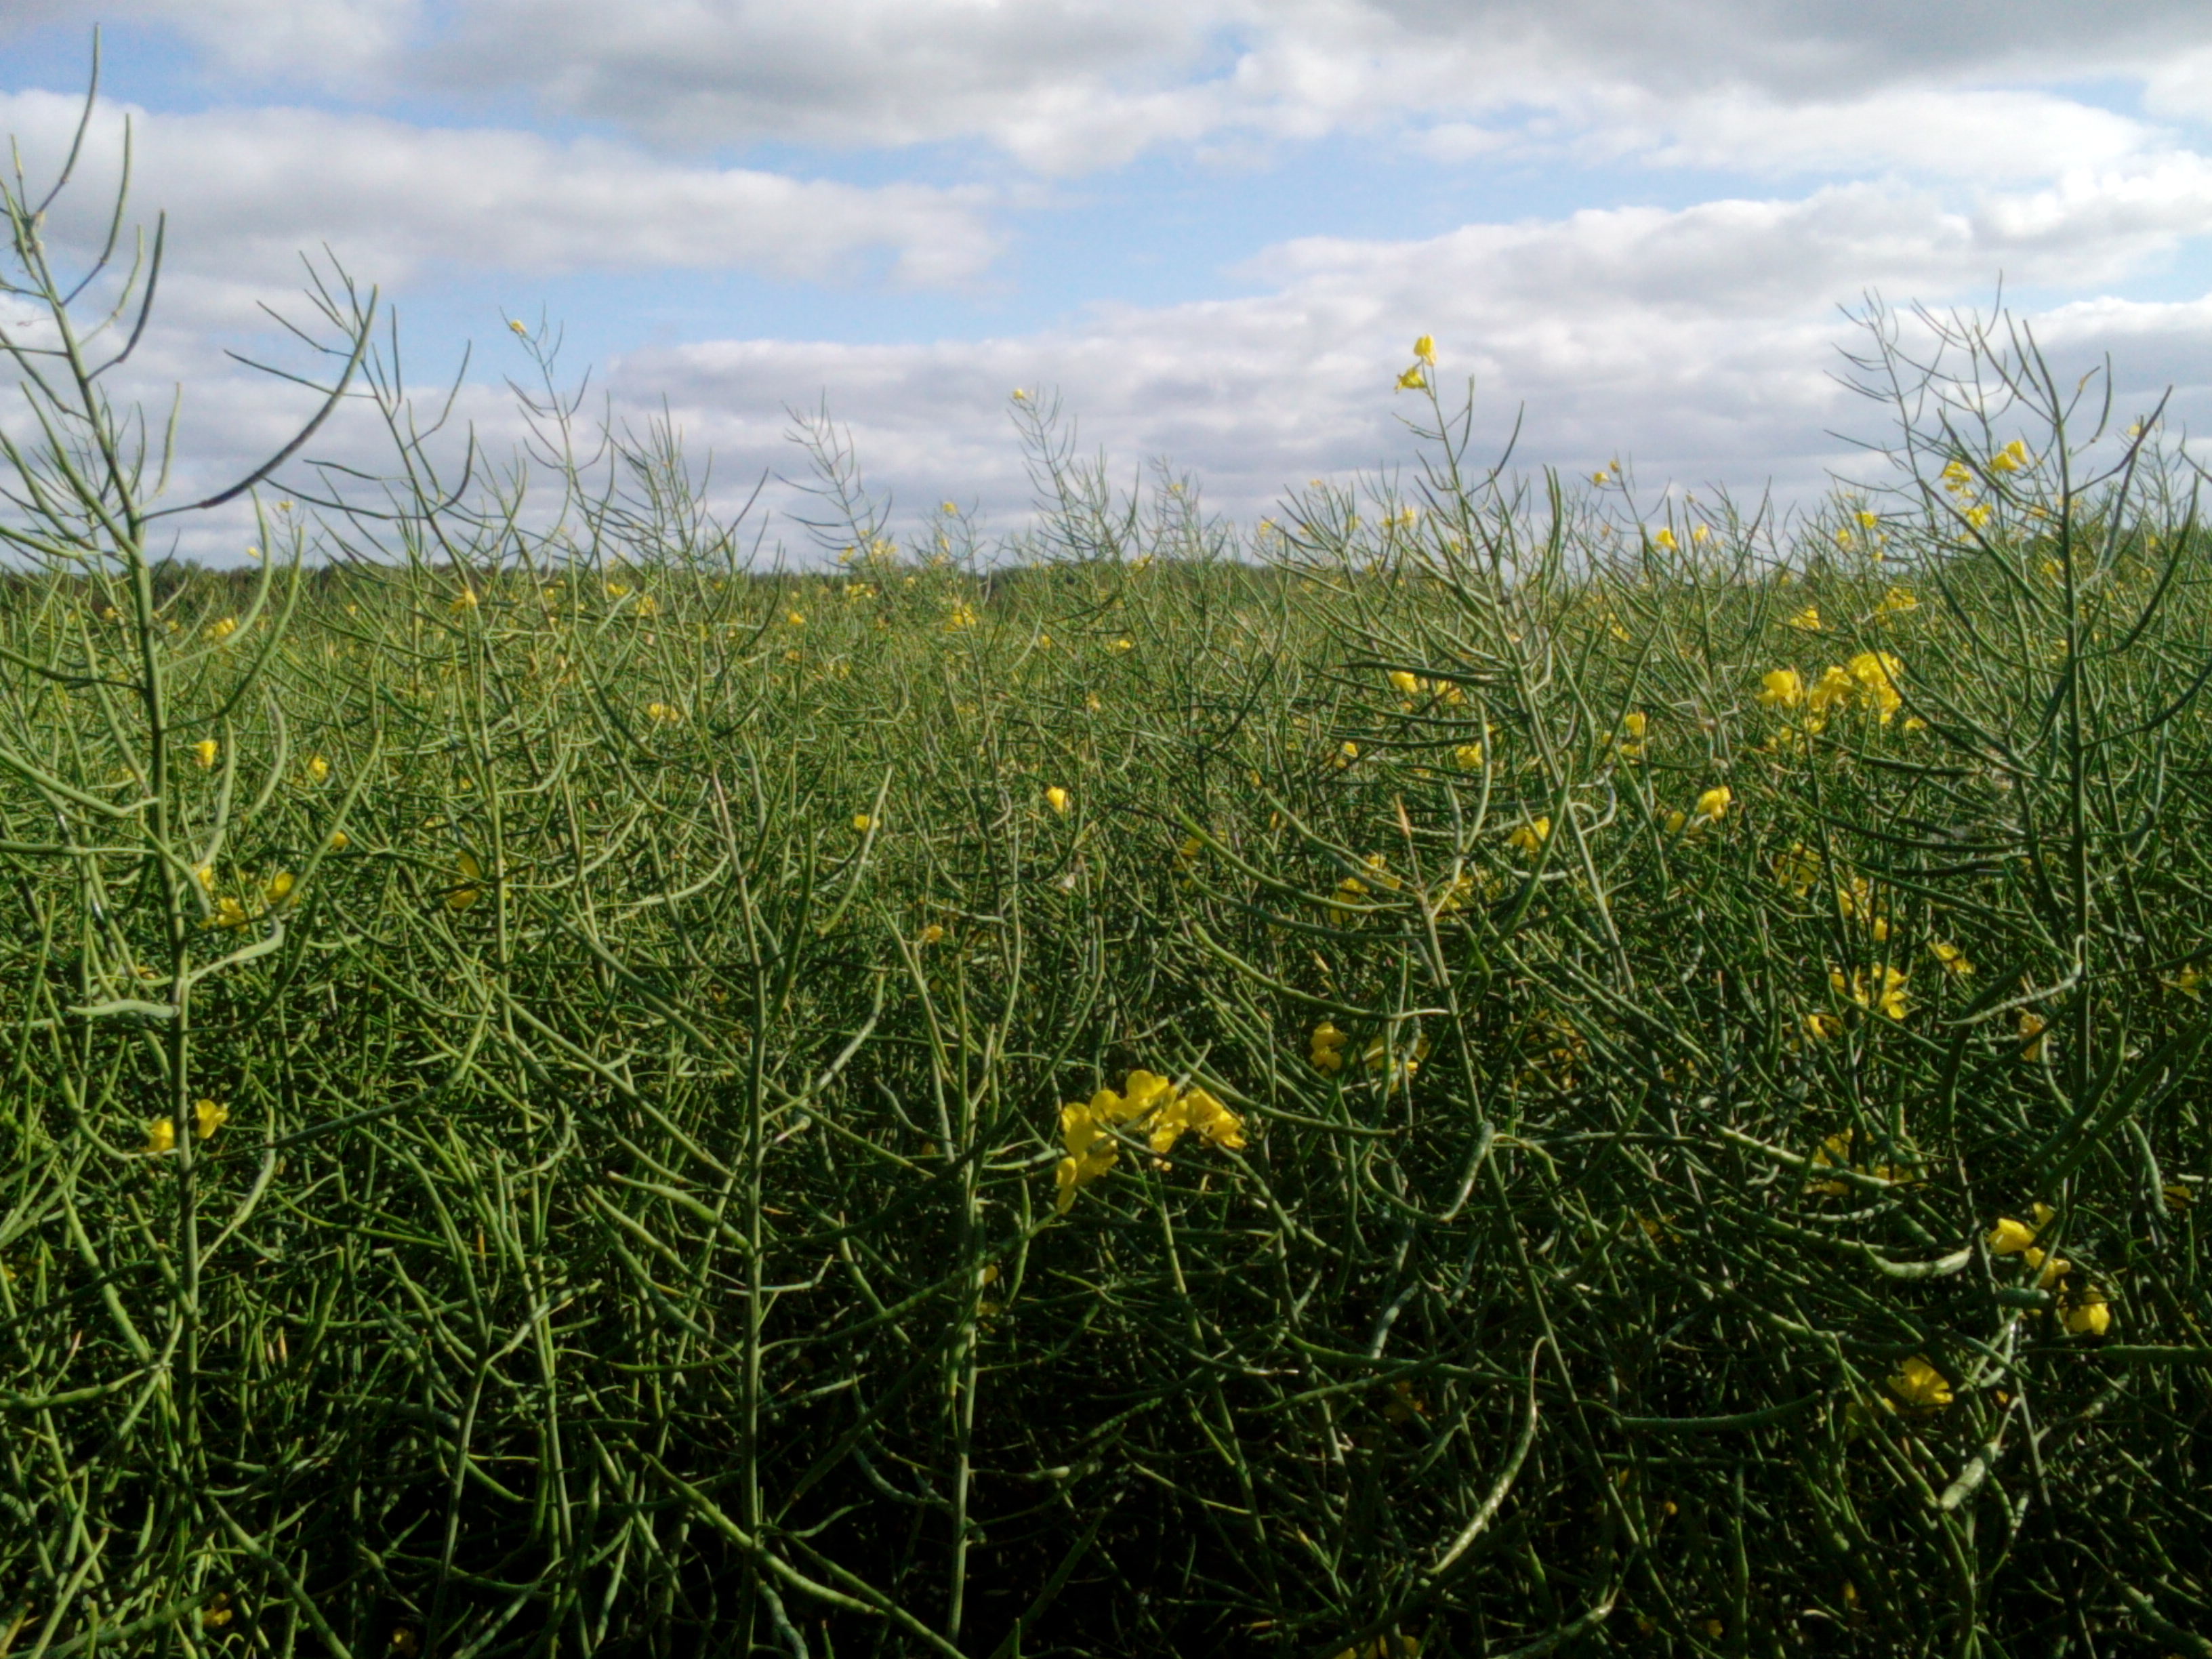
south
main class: Cropland
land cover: Rape and turnip rape
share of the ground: > 75 %
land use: Agriculture (excluding fallow land and kitchen gardens)
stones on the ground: < 10 %
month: June
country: LV
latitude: 56.6940
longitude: 22.2169
